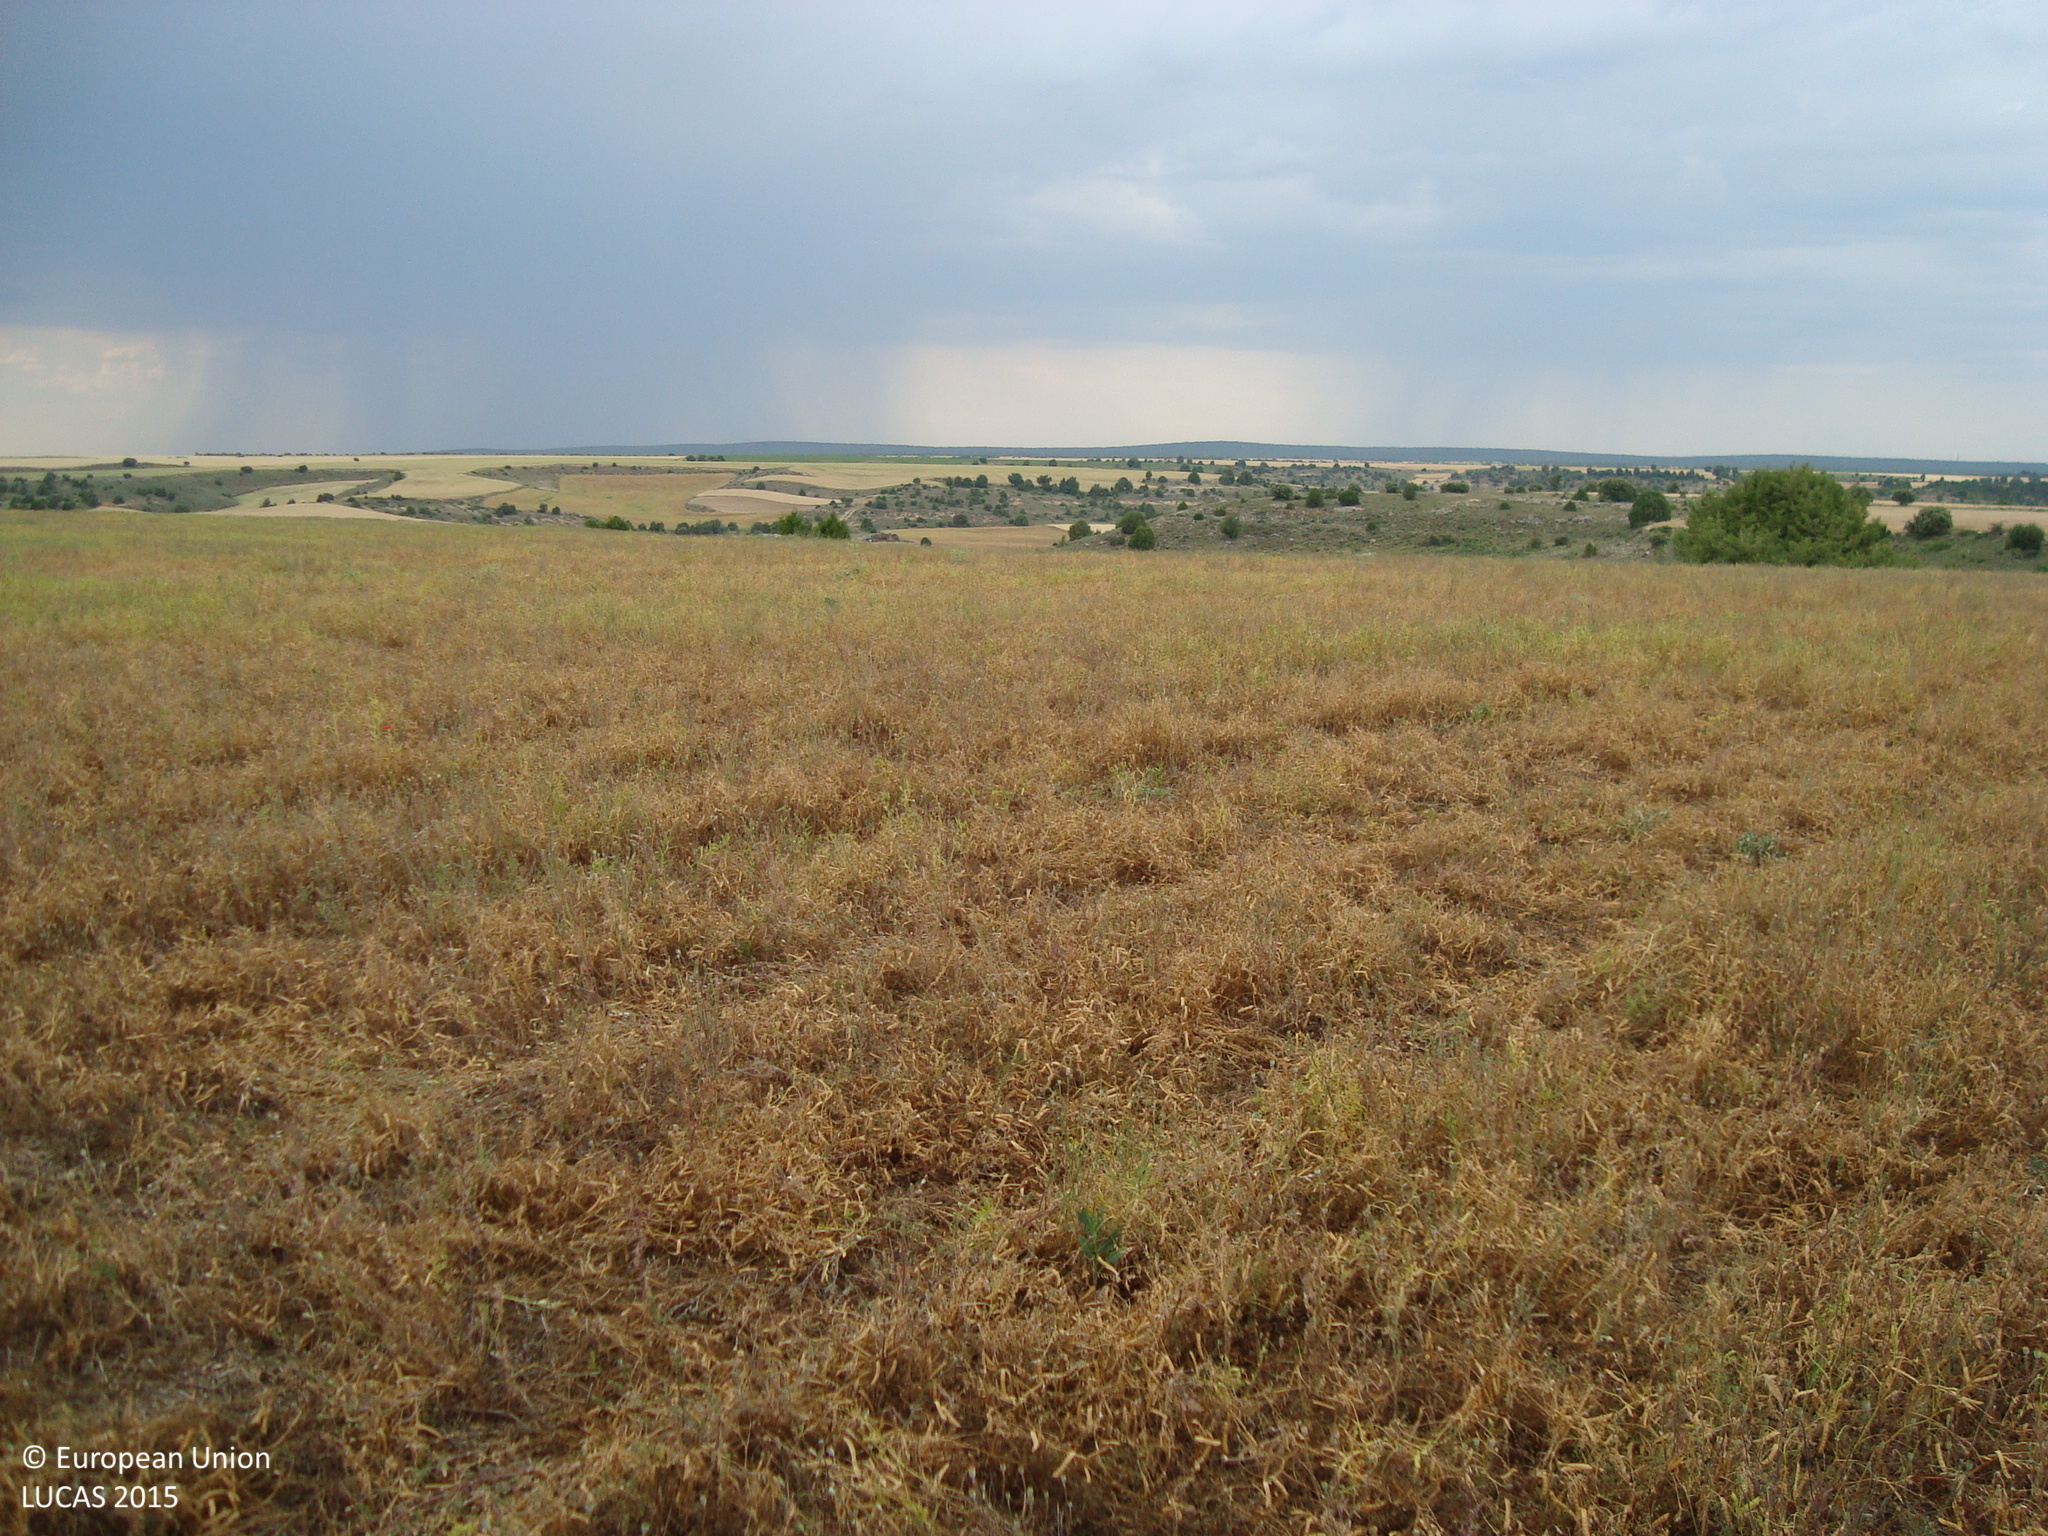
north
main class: Cropland
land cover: Dry pulses
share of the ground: > 75 %
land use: Agriculture (excluding fallow land and kitchen gardens)
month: June
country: ES
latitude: 41.8993
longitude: -3.7127
